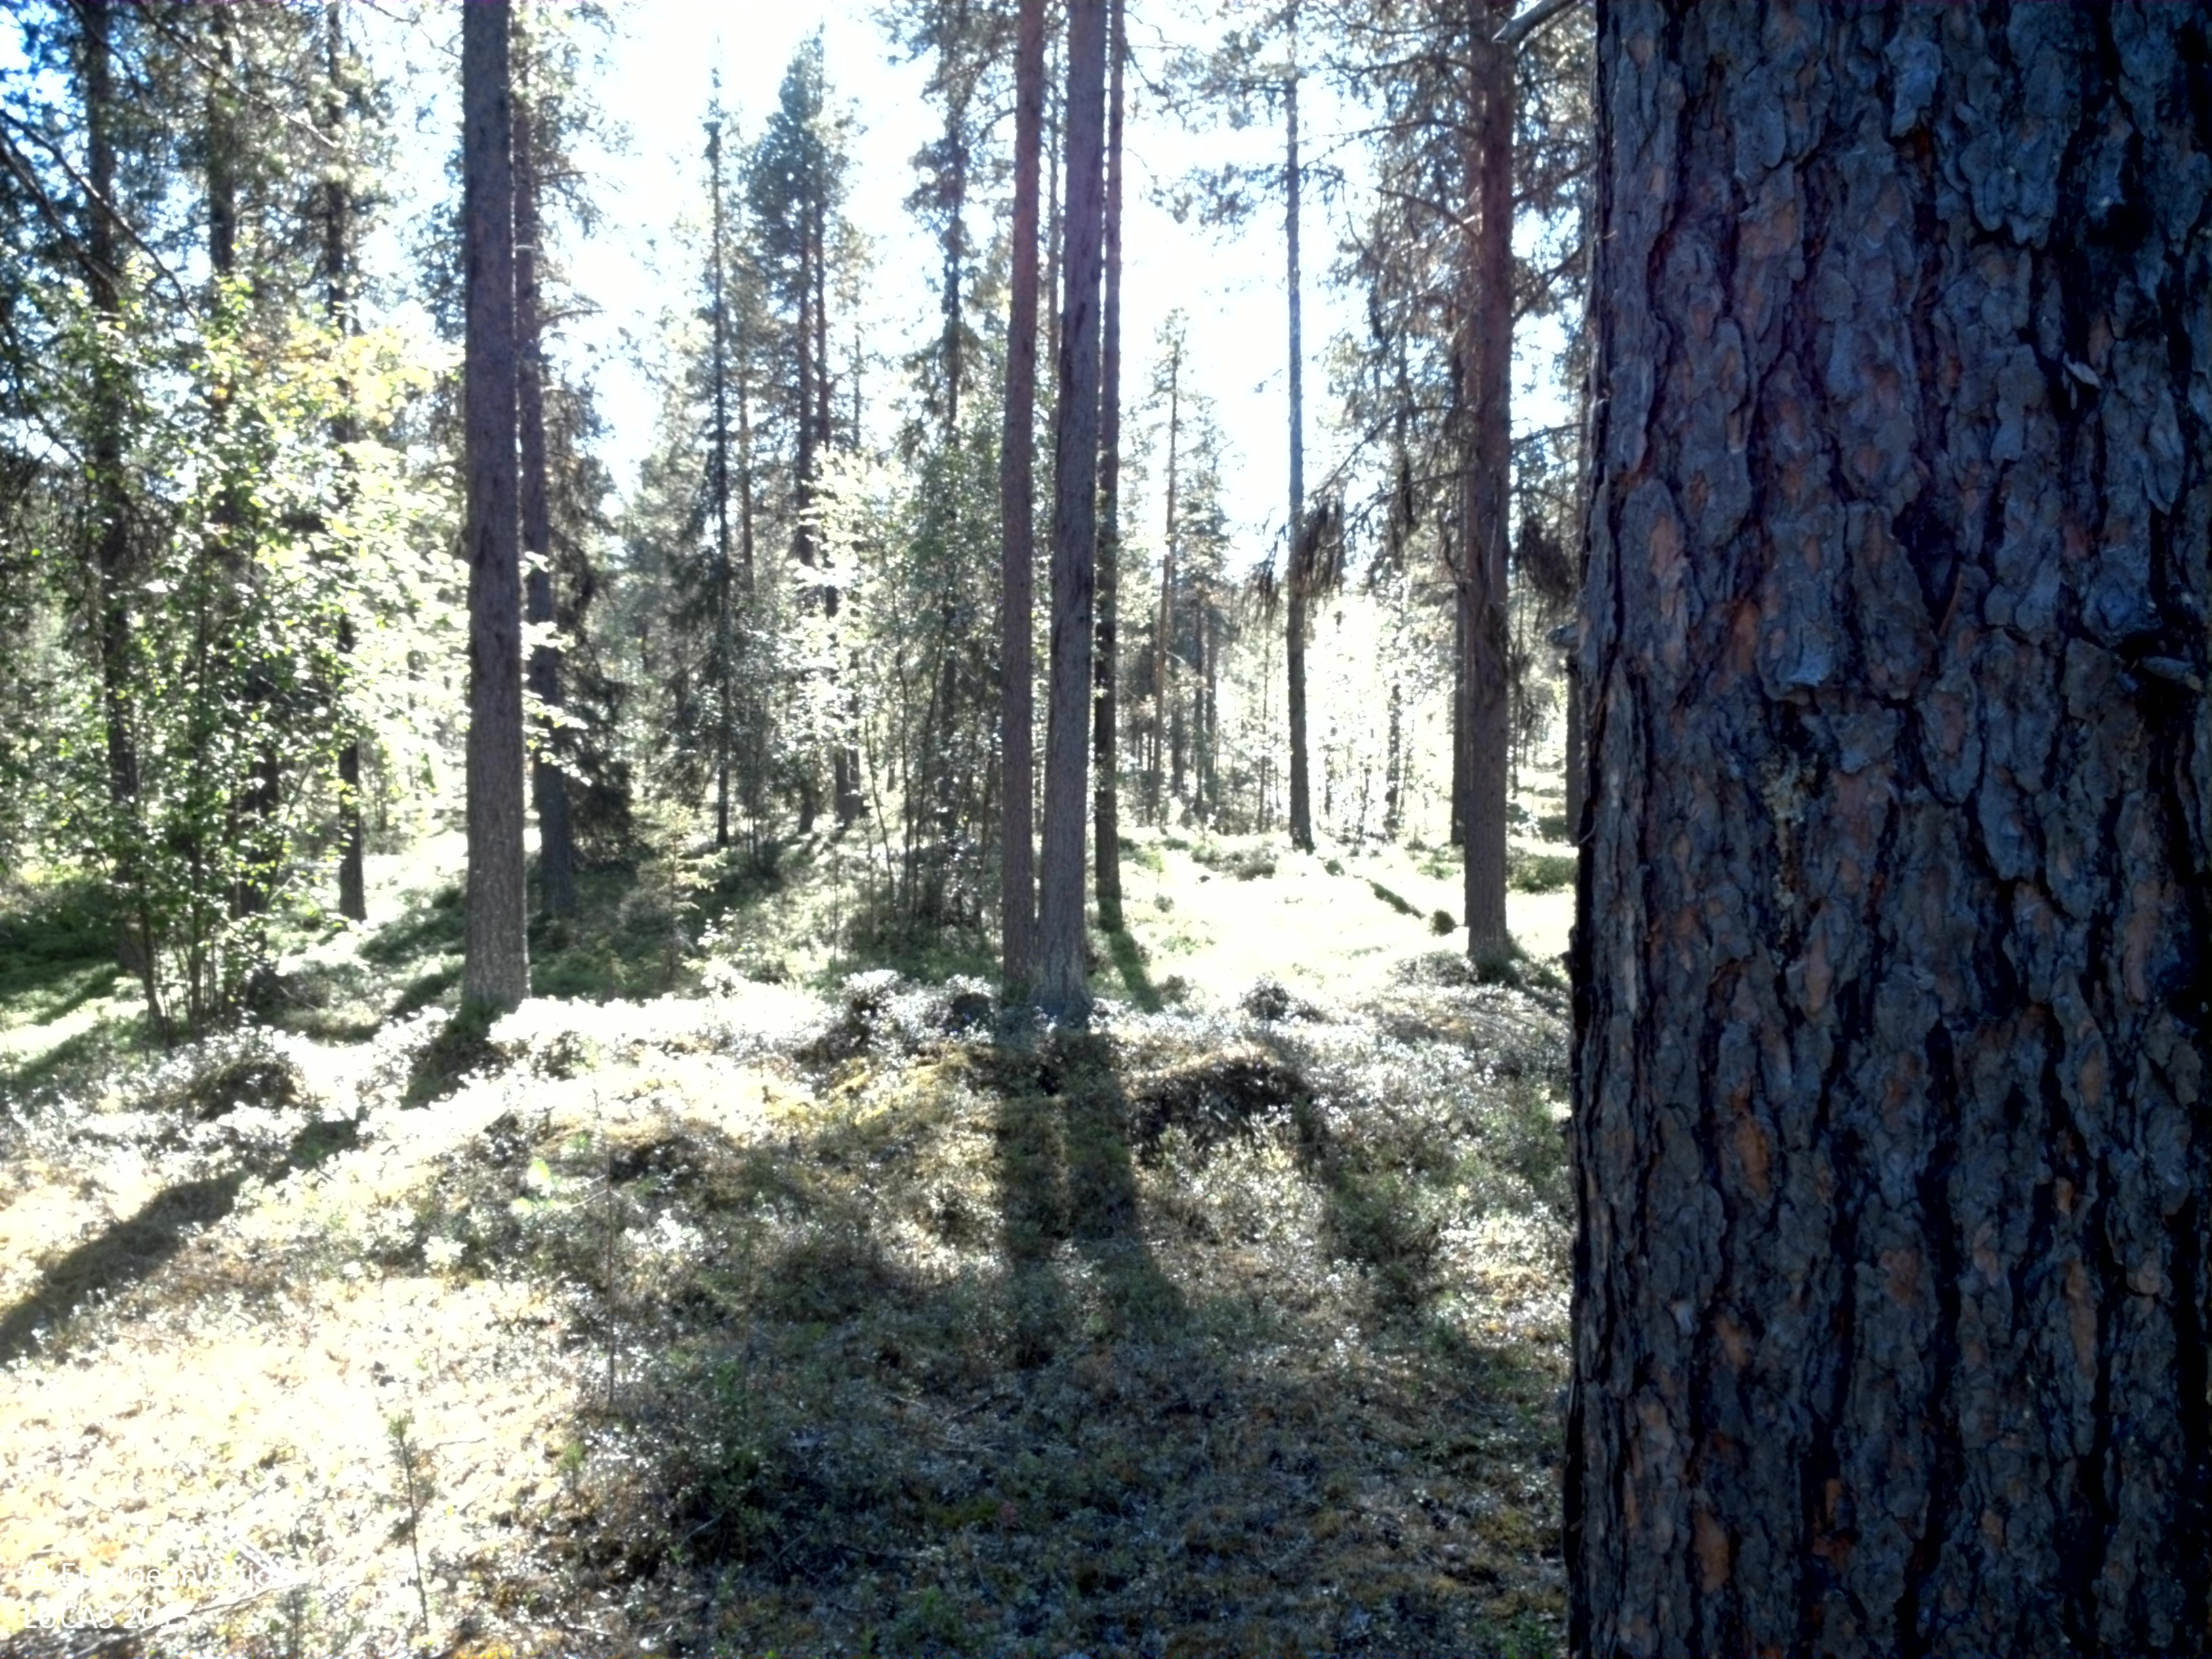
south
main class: Woodland
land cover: Pine dominated coniferous woodland
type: boreal forest
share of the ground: 25 - 50 %
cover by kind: shrubs 55 %, coniferous forest trees 35 %, broadleaved forest trees 5 %, lichens and mosses 5 %
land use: Forestry
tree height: > 5 m
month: August
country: SE
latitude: 66.6847
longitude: 18.8024
